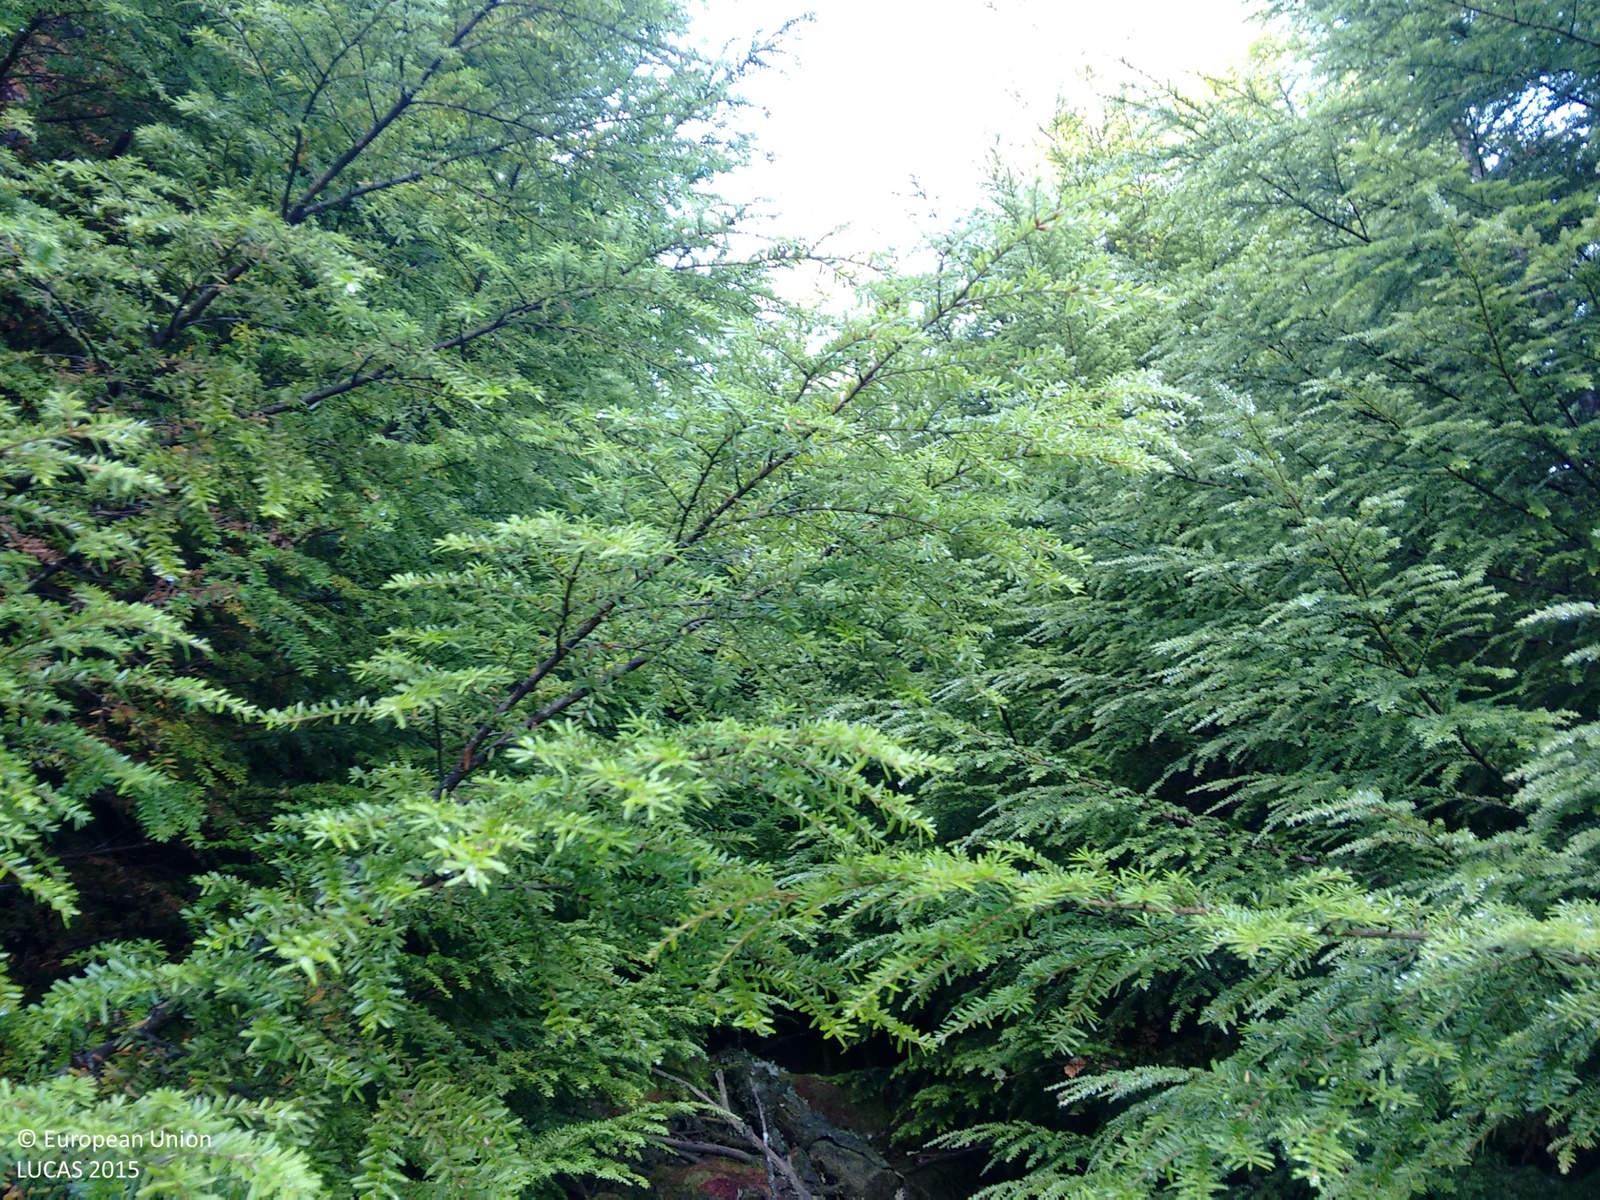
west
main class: Woodland
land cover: Spruce dominated coniferous woodland
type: exotic forest
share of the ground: > 75 %
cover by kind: coniferous forest trees 100 %
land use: Forestry
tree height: > 5 m
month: September
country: GB
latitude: 55.8252
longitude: -5.4951
